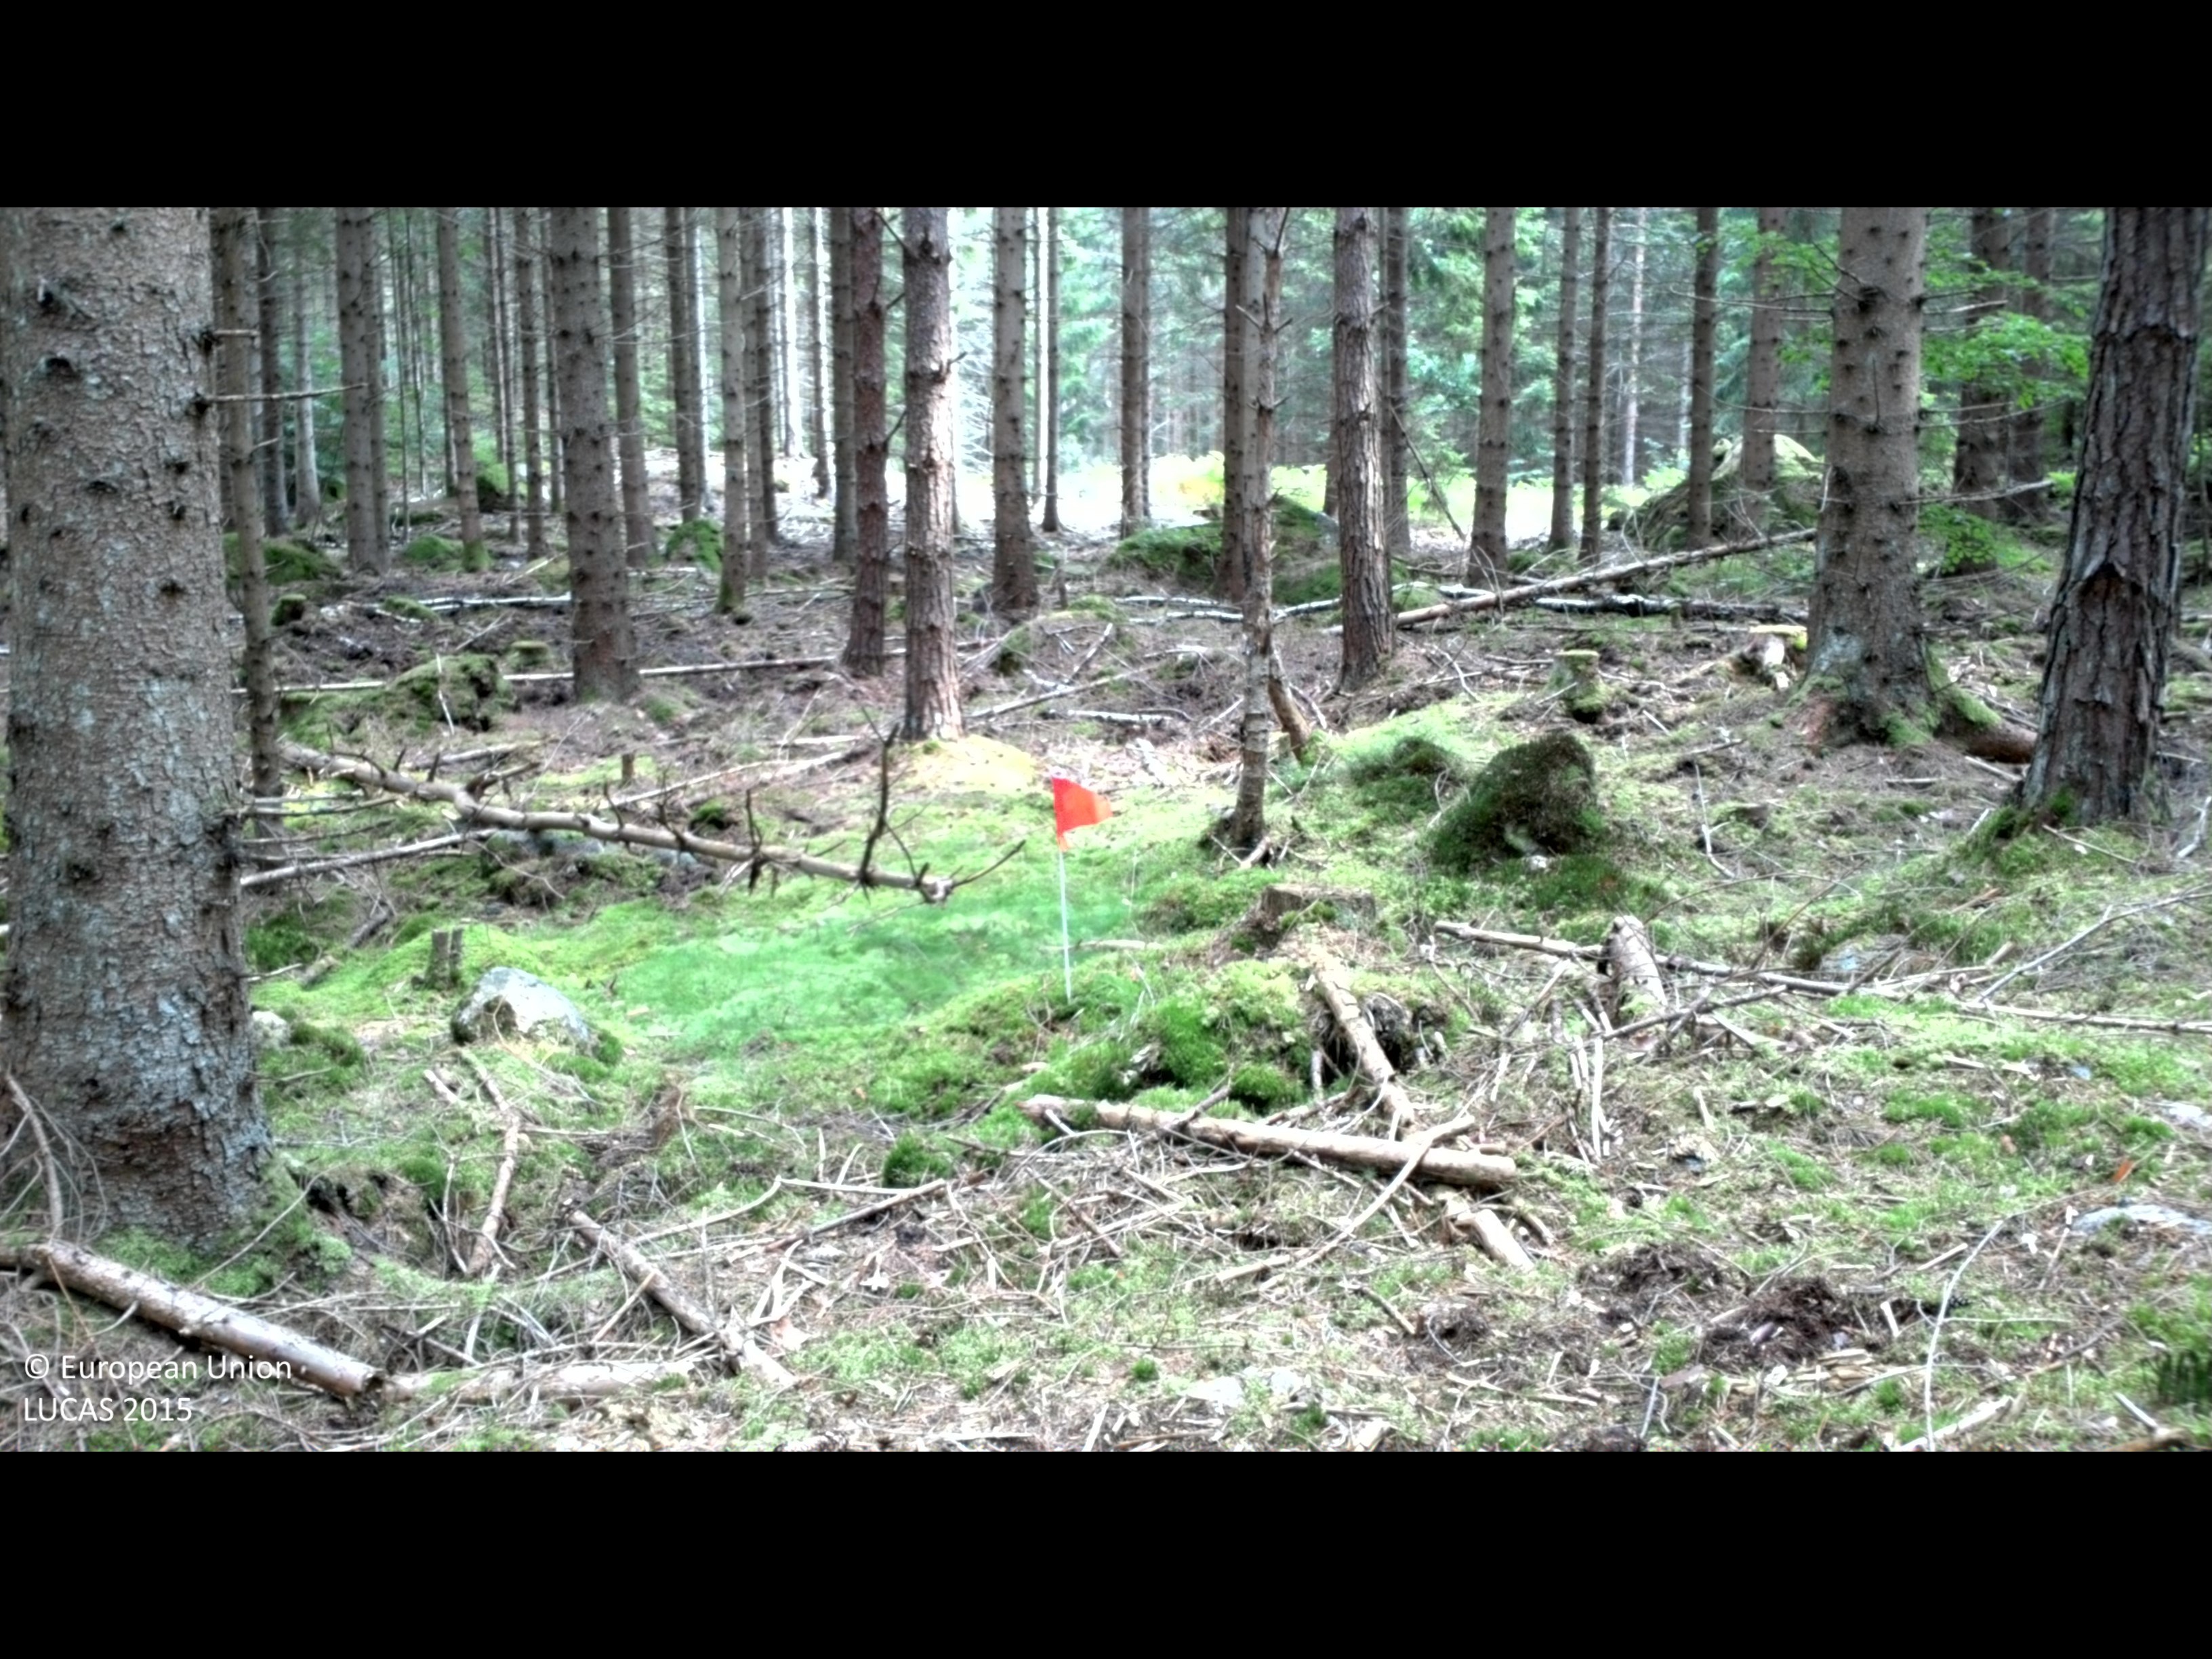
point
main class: Woodland
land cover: Spruce dominated coniferous woodland
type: boreal forest
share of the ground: 50 - 75 %
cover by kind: coniferous forest trees 65 %, lichens and mosses 35 %
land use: Forestry
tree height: > 5 m
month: August
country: SE
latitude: 56.3389
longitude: 15.0942
